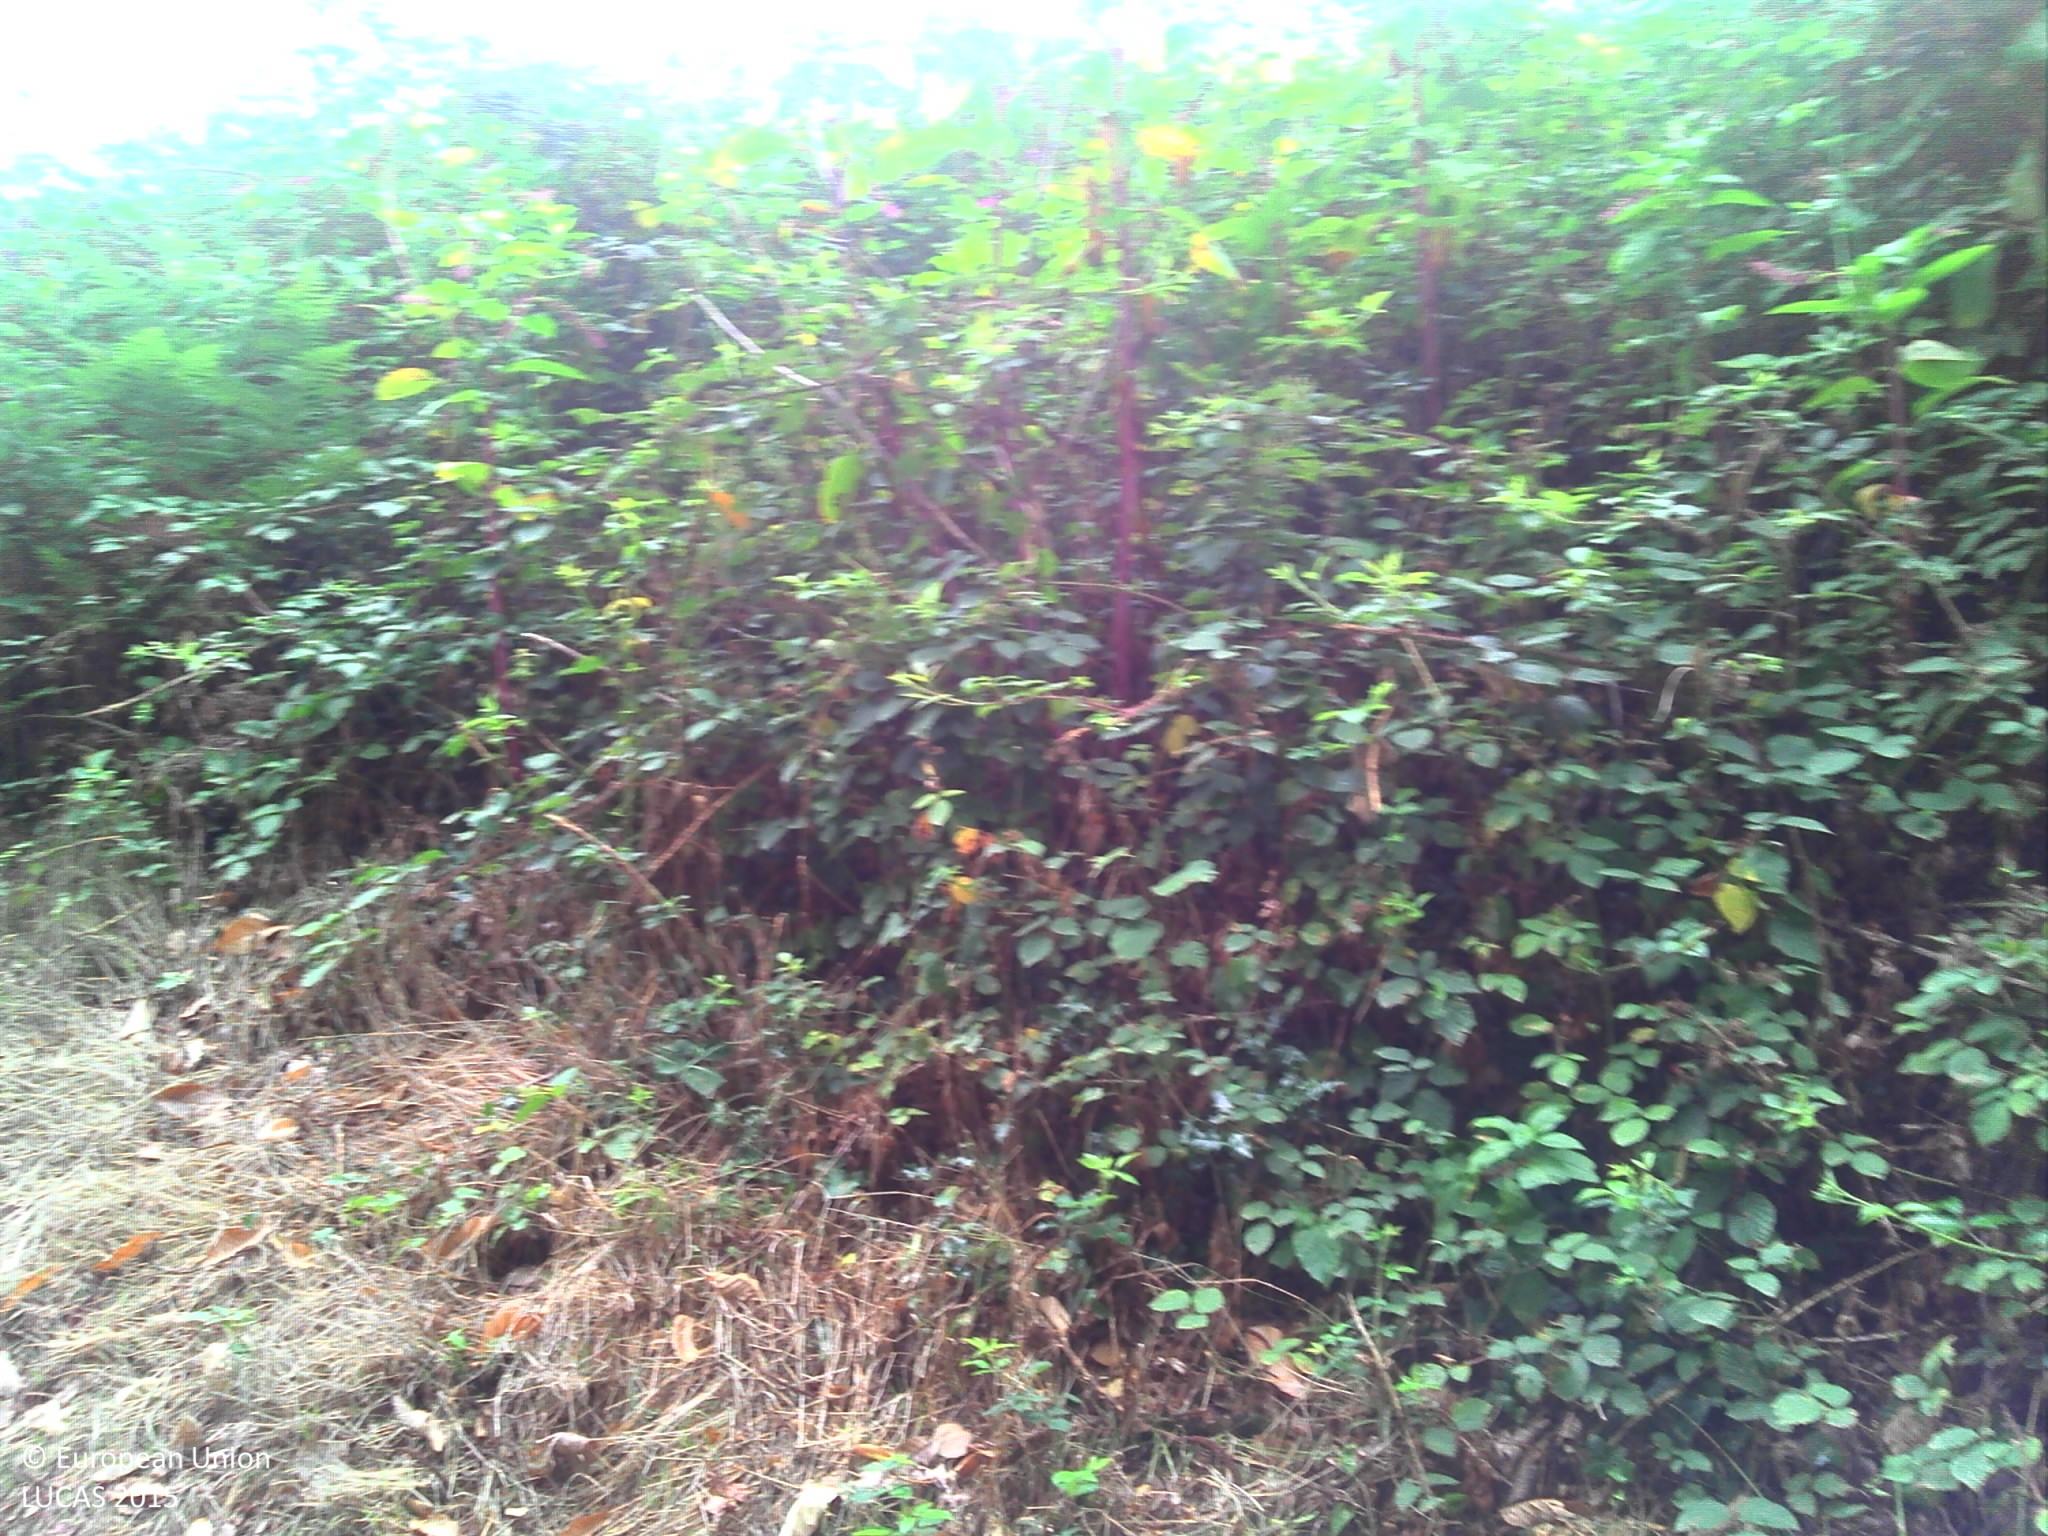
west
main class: Grassland
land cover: Grassland without tree/shrub cover
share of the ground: > 75 %
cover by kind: herbaceous plants 100 %
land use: Agriculture (excluding fallow land and kitchen gardens)
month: August
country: FR
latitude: 46.0220
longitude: 0.9586
